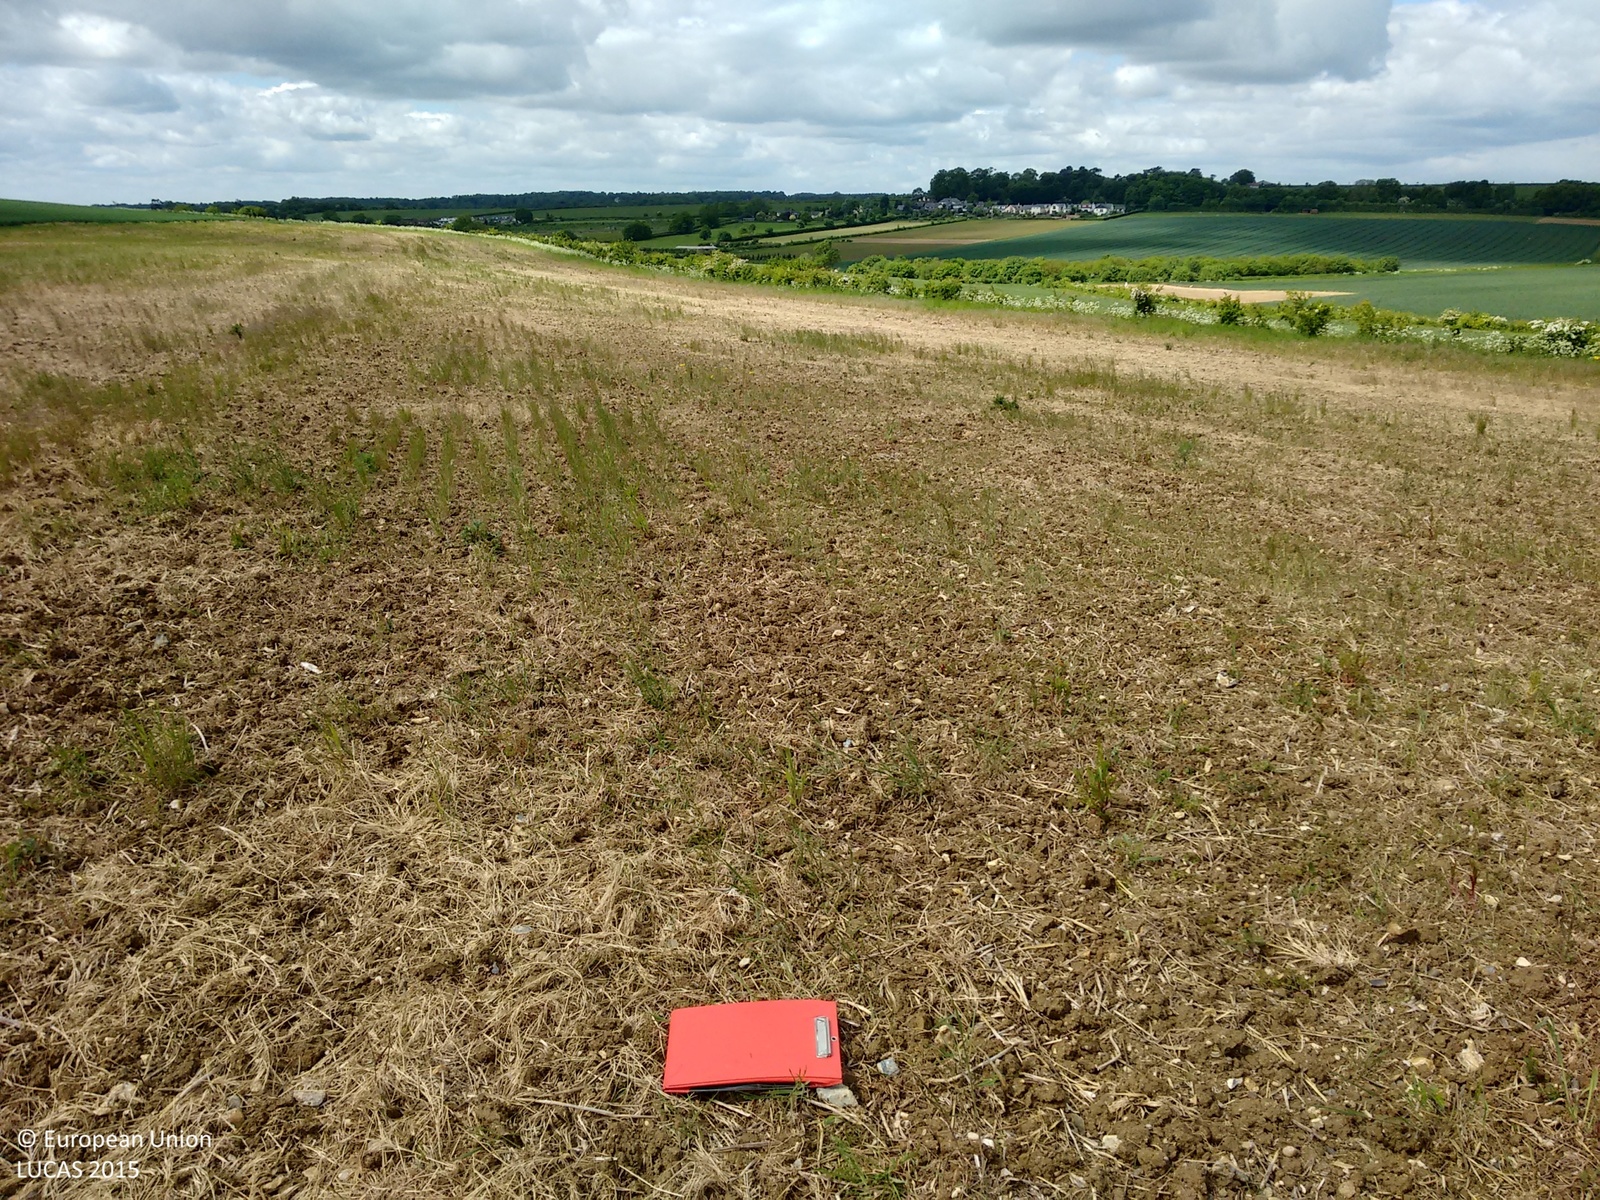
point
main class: Grassland
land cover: Spontaneously vegetated surfaces
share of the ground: 25 - 50 %
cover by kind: unconsolidated bare surface 60 %, herbaceous plants 40 %
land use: Fallow land
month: May
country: GB
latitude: 51.9211
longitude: 0.0366
